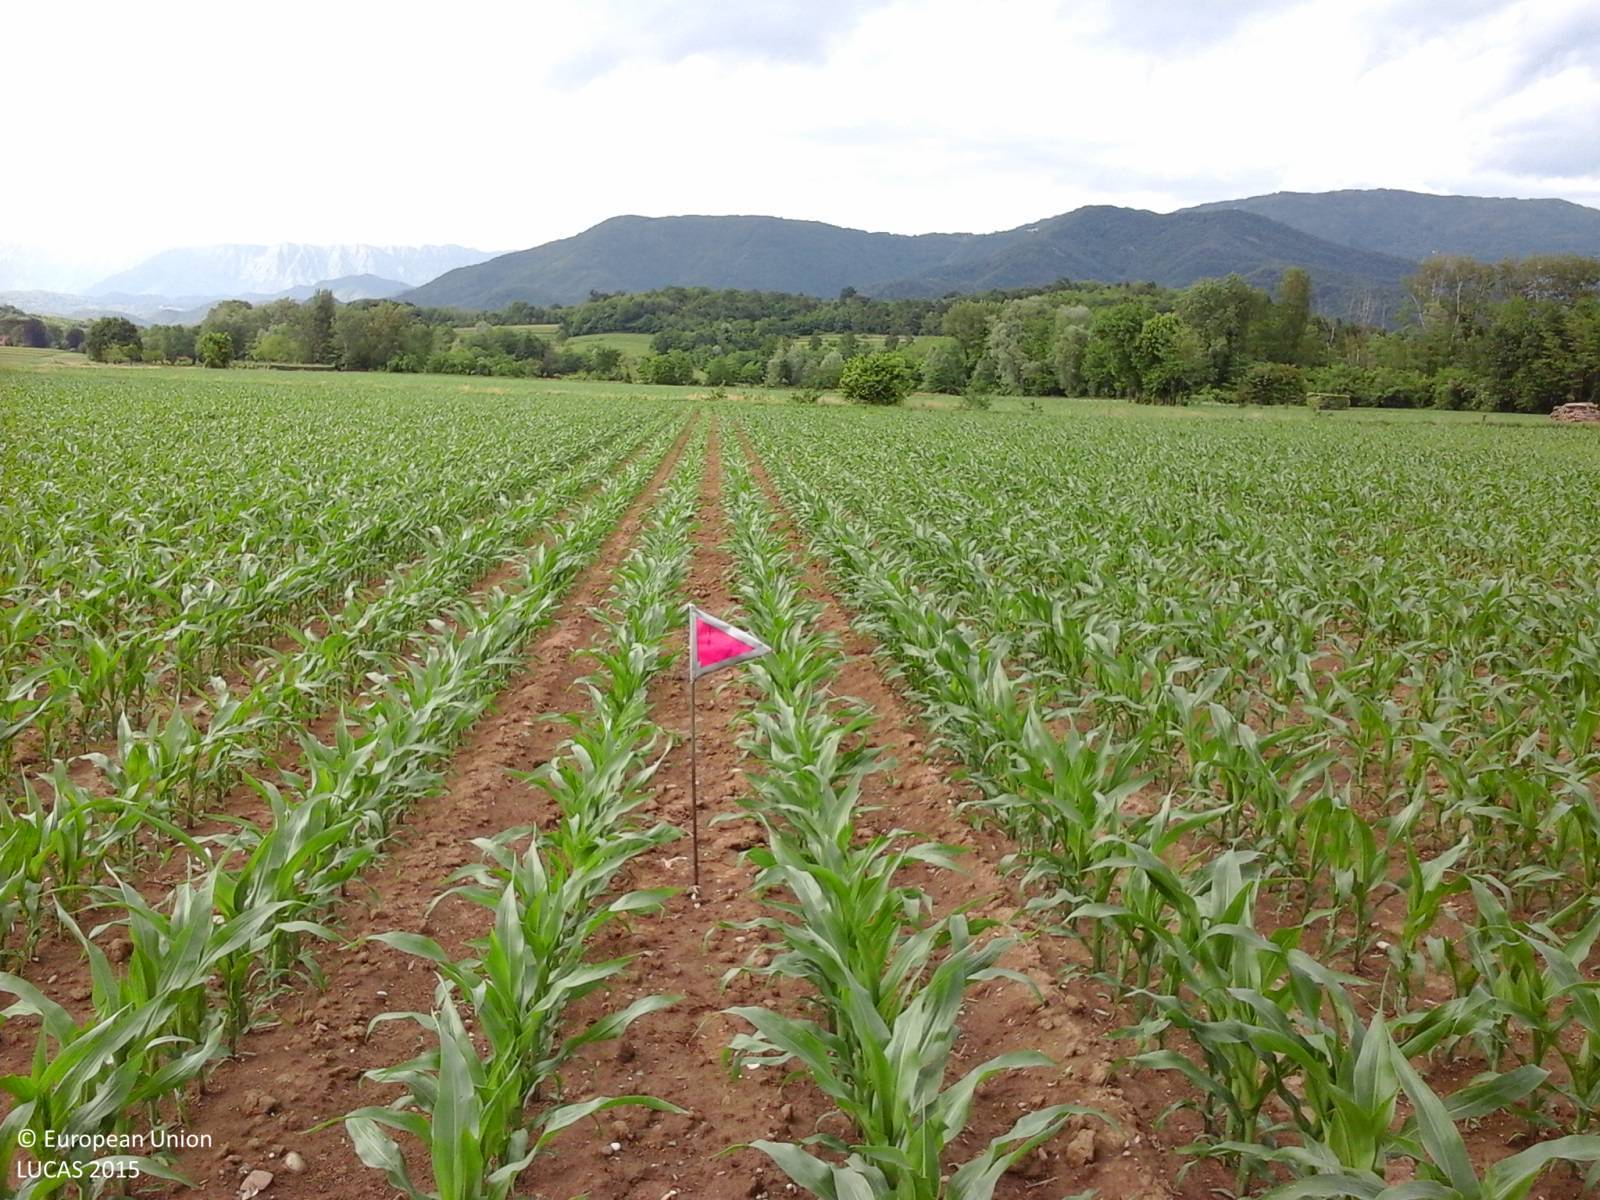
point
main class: Cropland
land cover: Maize
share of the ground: 50 - 75 %
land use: Agriculture (excluding fallow land and kitchen gardens)
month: May
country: IT
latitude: 46.1374
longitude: 13.3232
